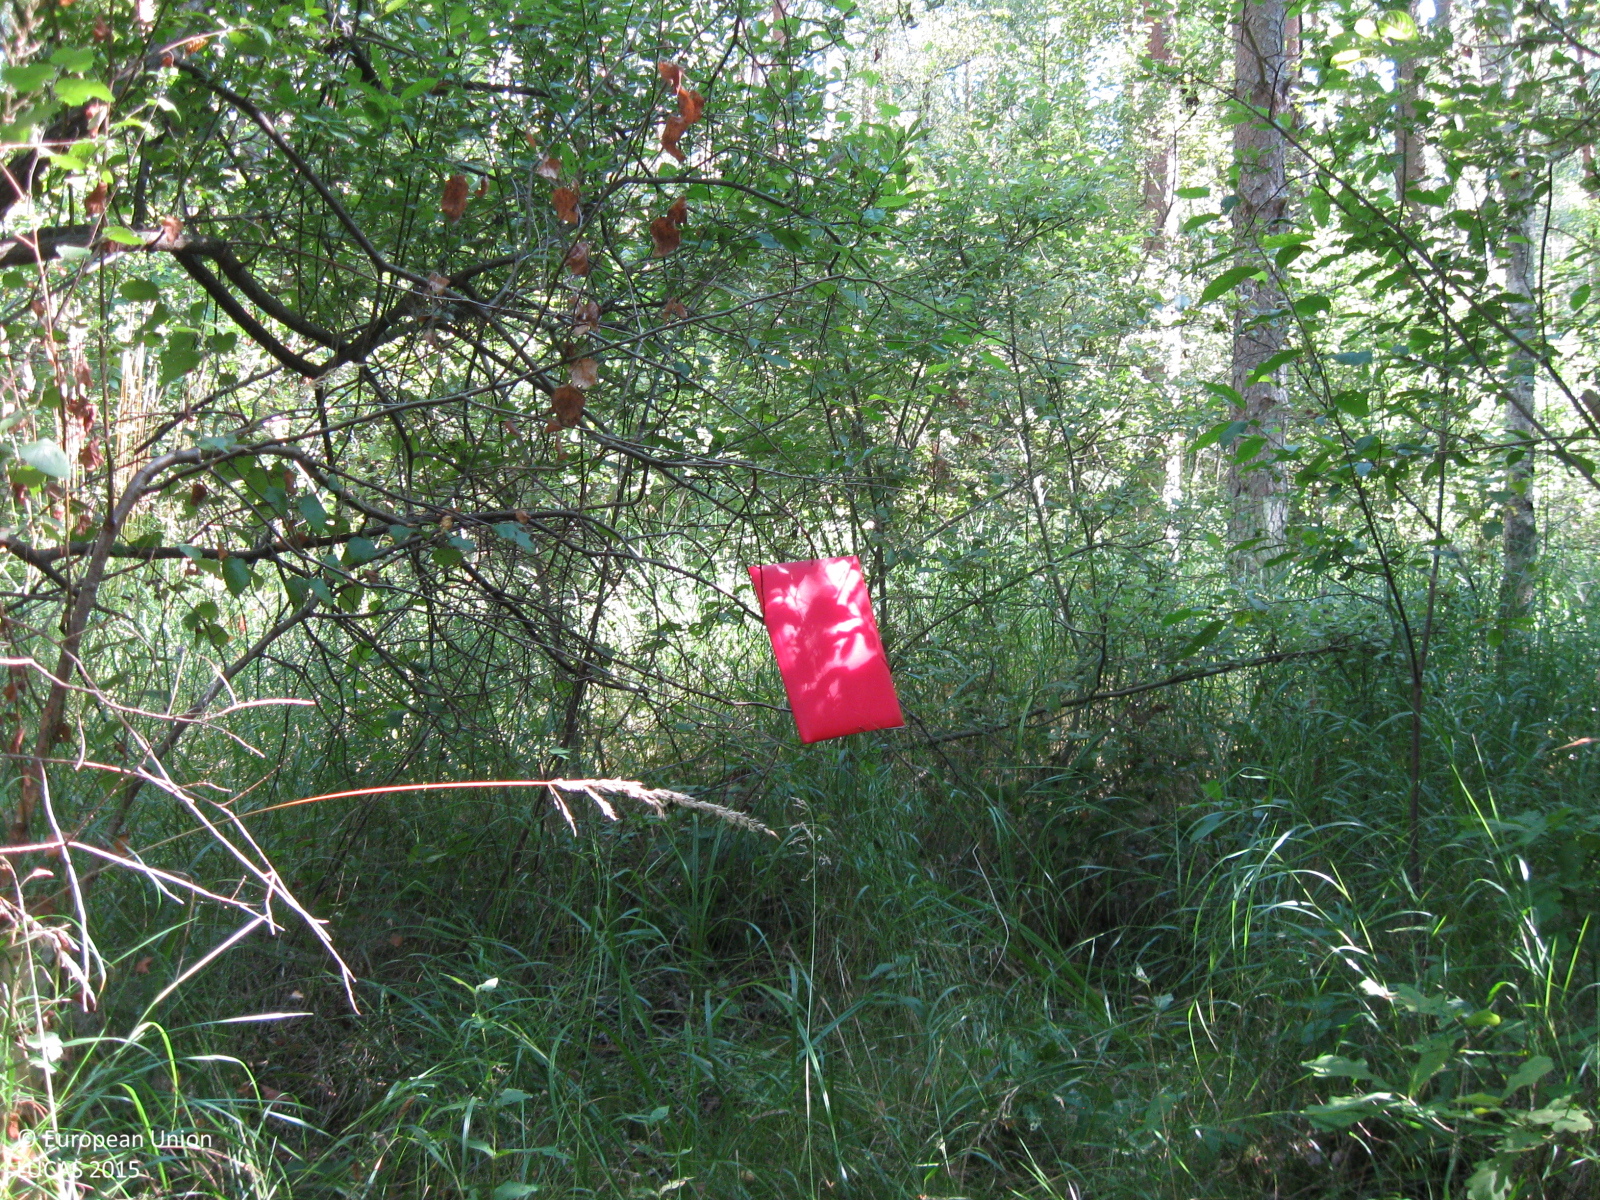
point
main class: Woodland
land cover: Pine dominated mixed woodland
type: hemiboreal forest and nemoral coniferous forest and mixed broadleaved-coniferous forest
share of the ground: > 75 %
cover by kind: coniferous forest trees 60 %, broadleaved forest trees 30 %, herbaceous plants 10 %
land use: Forestry
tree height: > 5 m
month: August
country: LT
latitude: 55.3044
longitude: 22.4583
